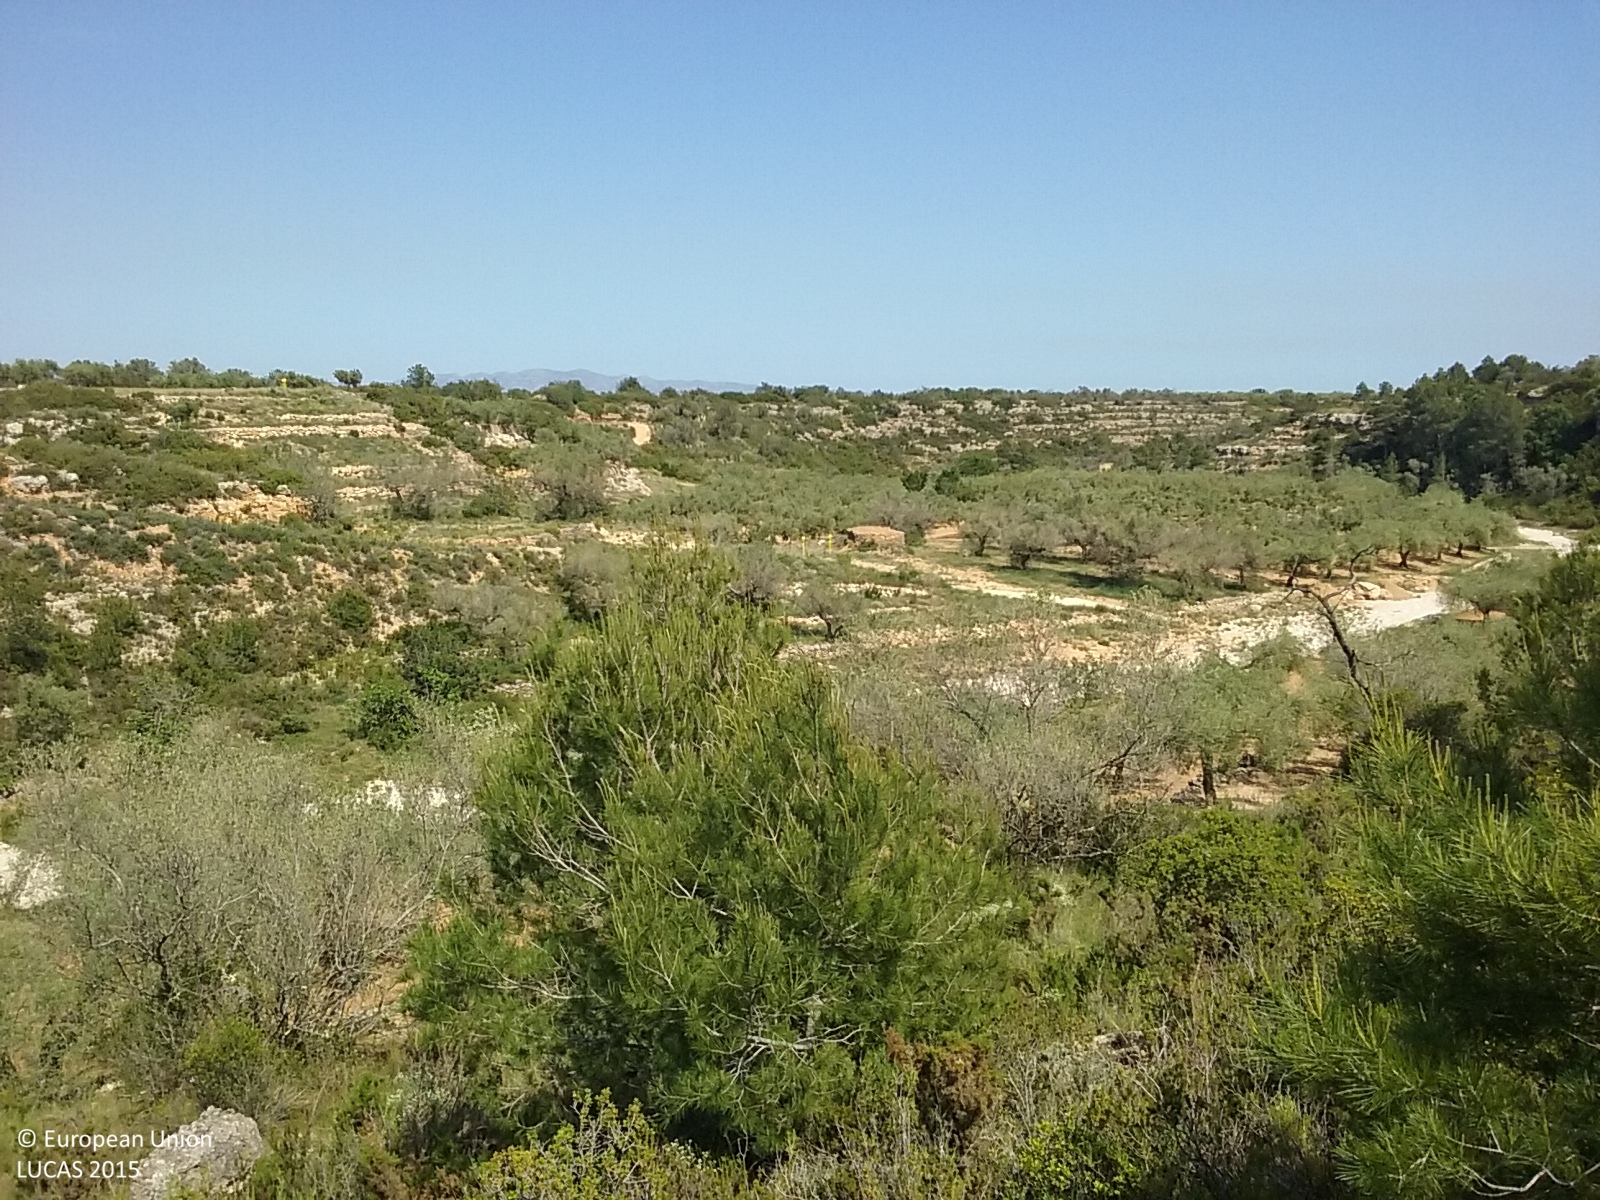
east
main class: Shrubland
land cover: Shrubland with sparse tree cover
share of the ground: > 75 %
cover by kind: shrubs 85 %, coniferous forest trees 5 %
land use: Semi-natural and natural areas not in use
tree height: > 5 m
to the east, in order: Shrubland with sparse tree cover; Olive groves; Dry stone walls; Olive groves; Dry stone walls; Olive groves; Dry stone walls; Tracks; Shrubland with sparse tree cover; Rocks and stones; Shrubland with sparse tree cover; Dry stone walls; Olive groves; Dry stone walls; Olive groves; Shrubland with sparse tree cover; Tracks; Shruby margins; Other bare soil; Grassland without tree/shrub cover; Dry stone walls; Olive groves; Dry stone walls; Tracks; Dry stone walls; Abandoned hedges; Olive groves
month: May
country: ES
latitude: 40.5862
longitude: 0.2948
